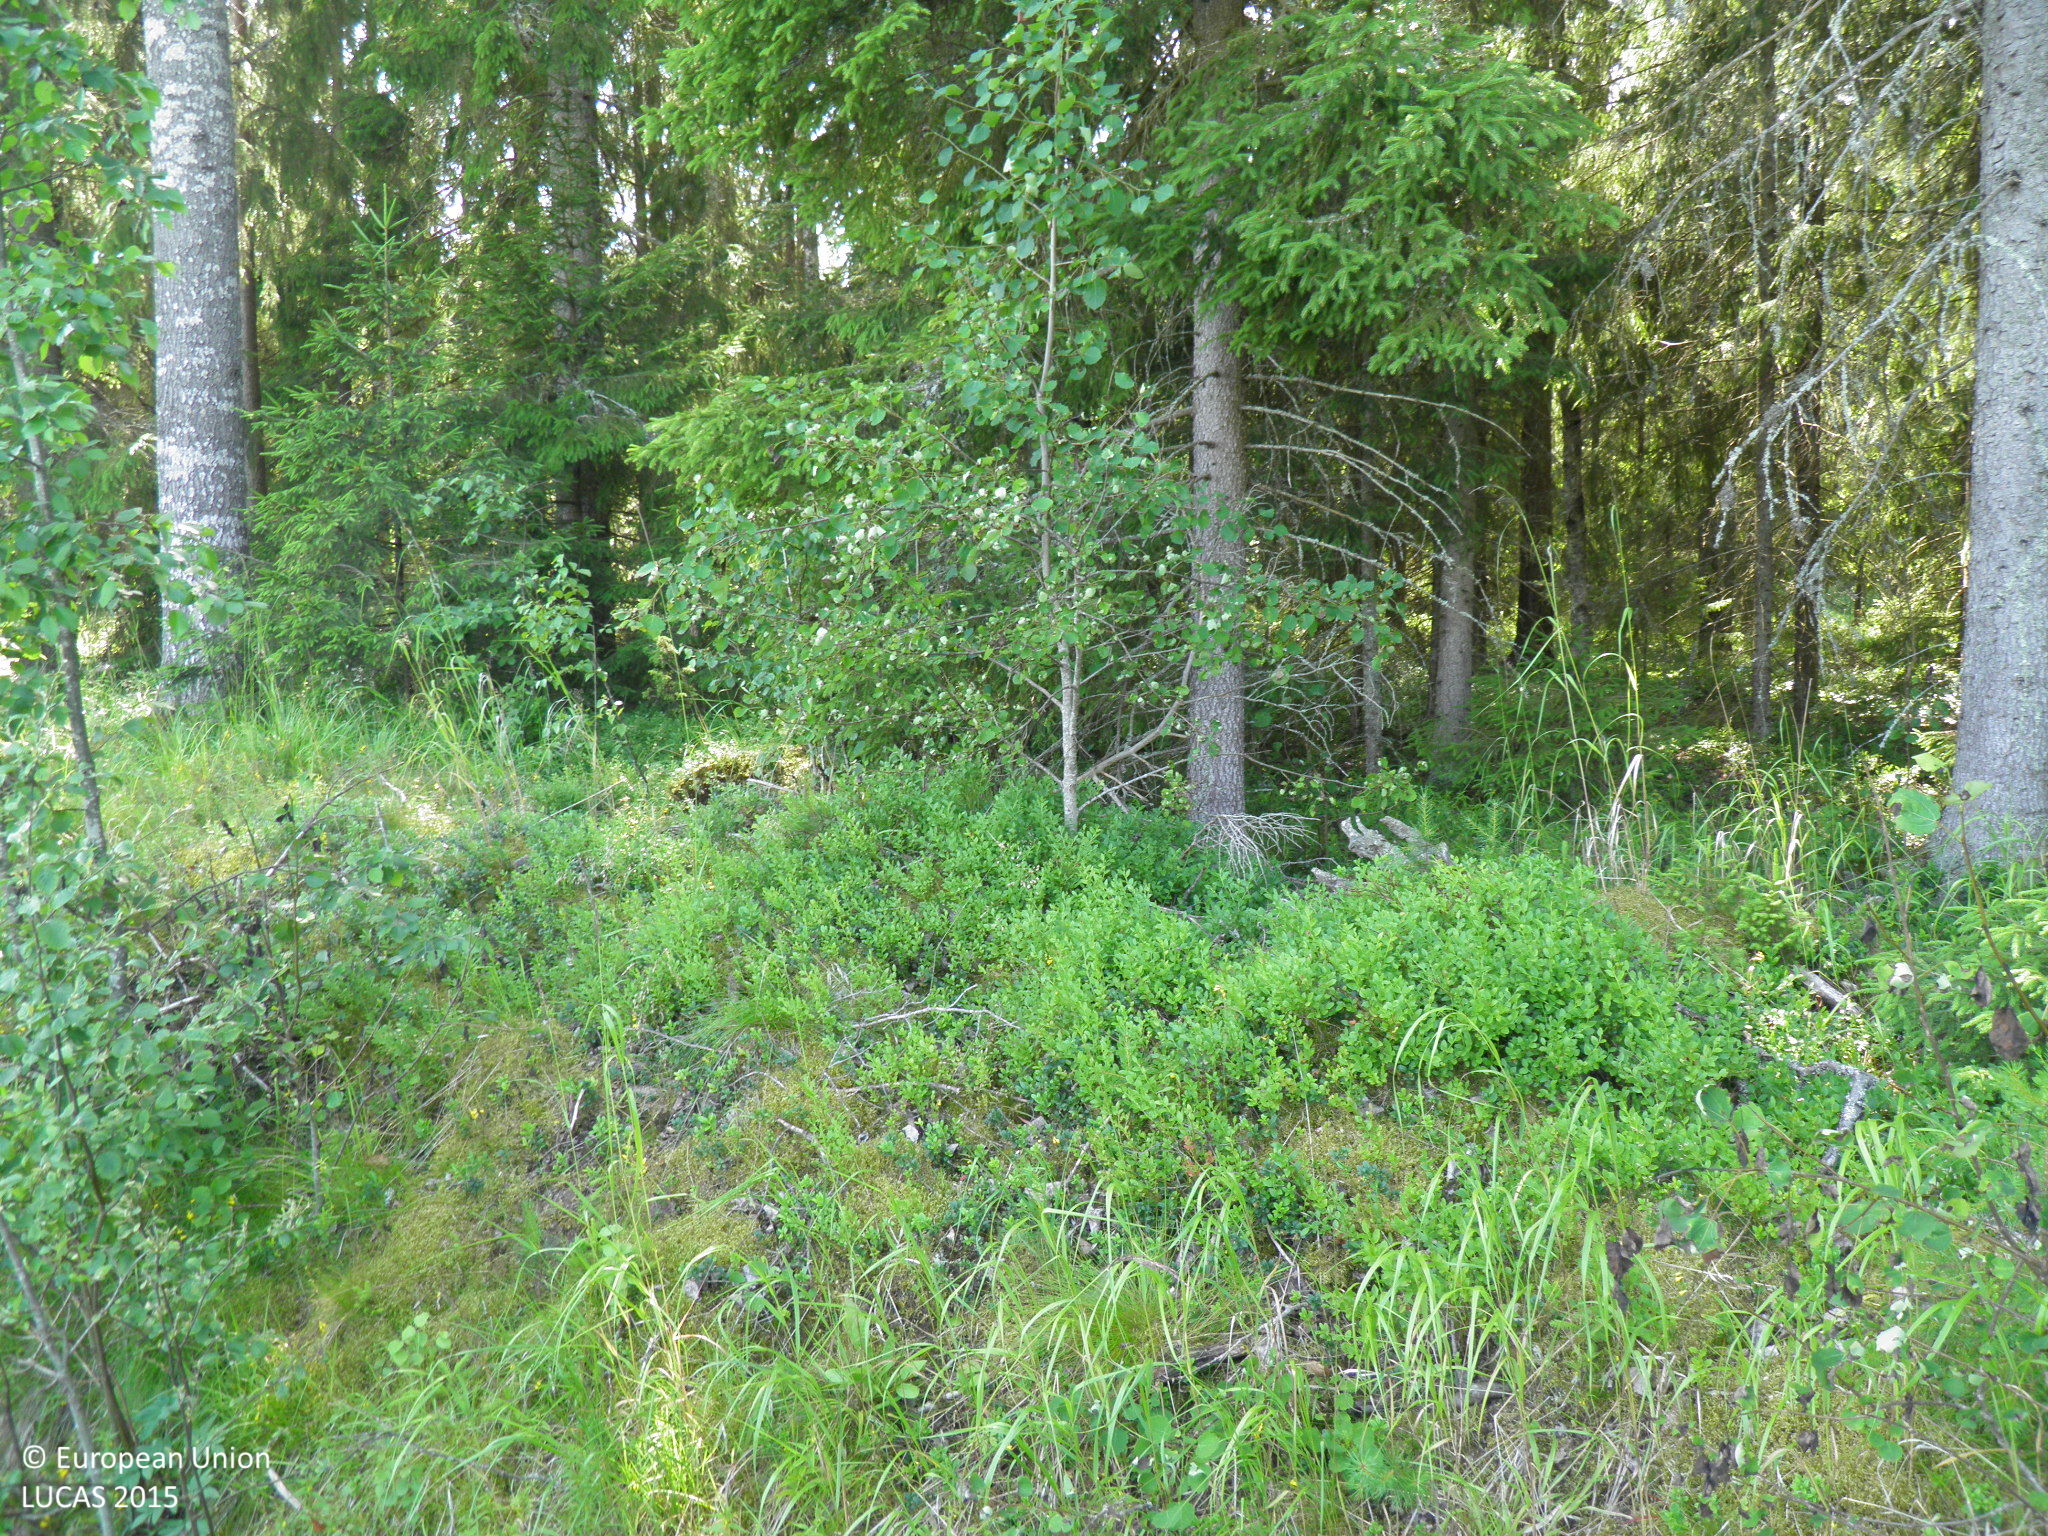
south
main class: Cropland
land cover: Barley
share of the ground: > 75 %
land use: Agriculture (excluding fallow land and kitchen gardens)
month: July
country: FI
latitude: 60.8820
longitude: 22.5030
